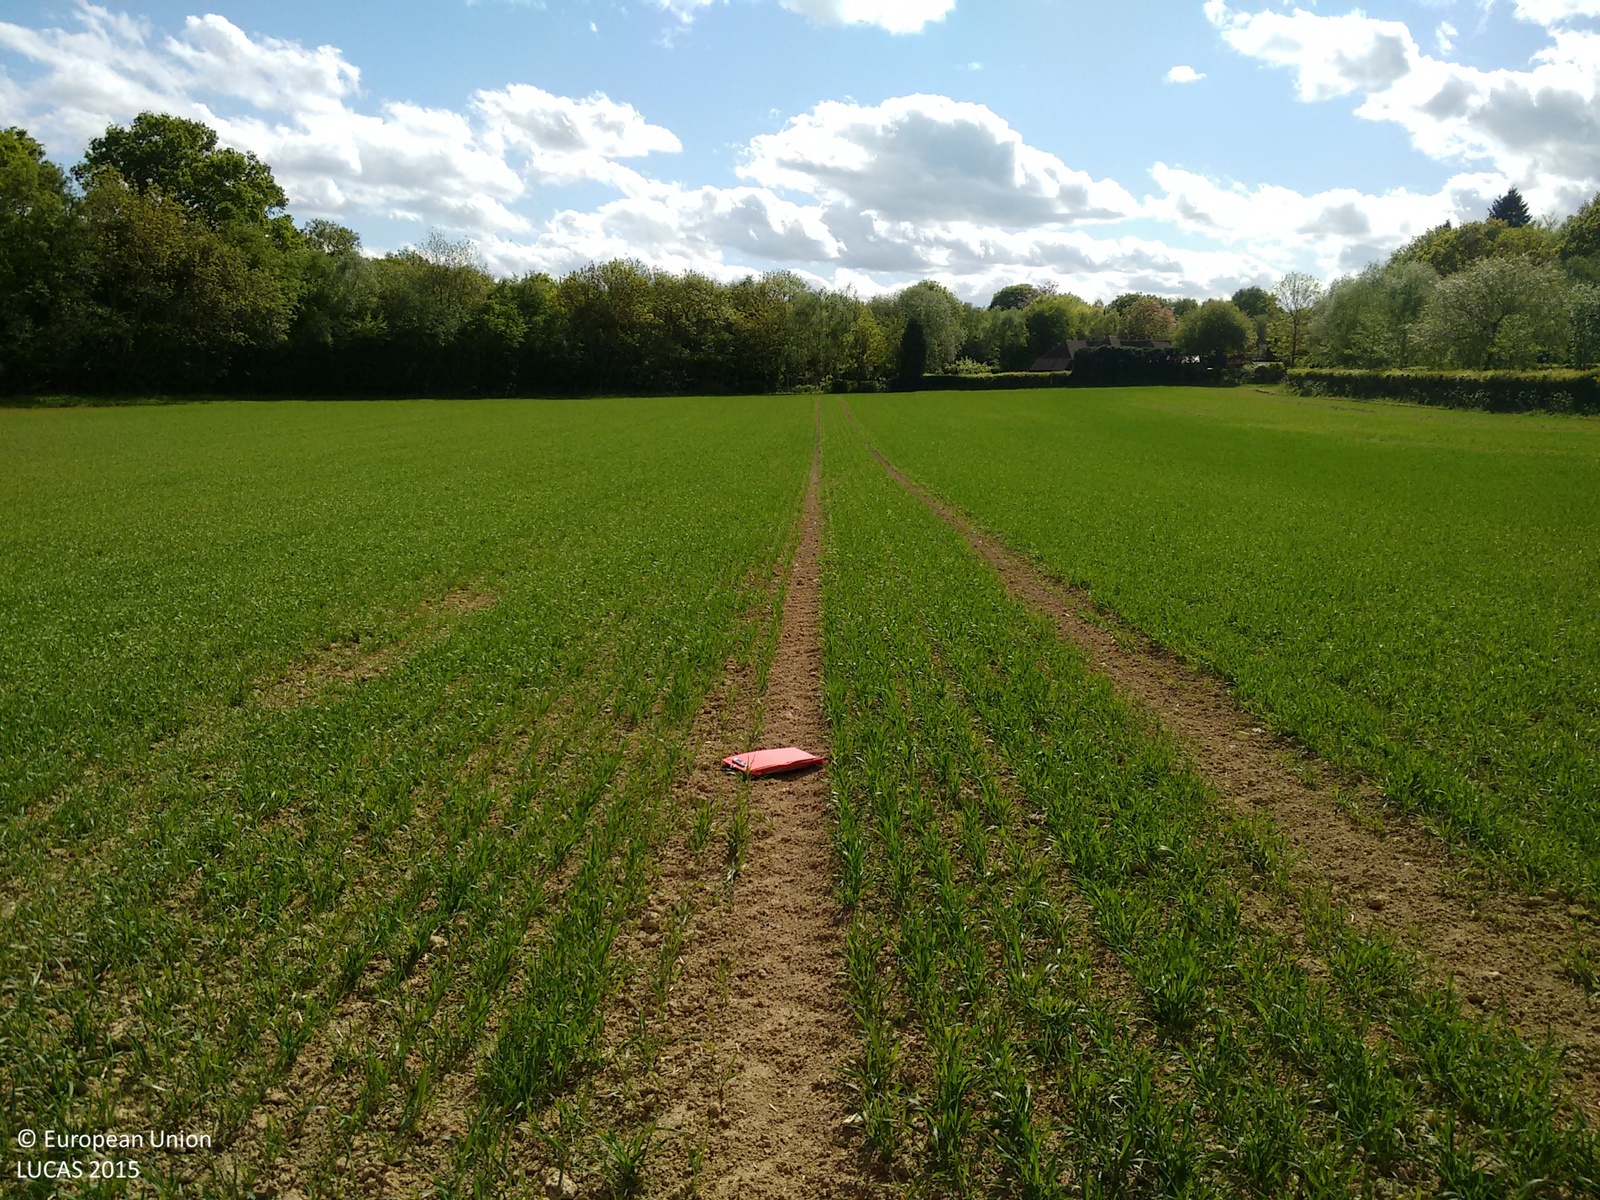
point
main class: Cropland
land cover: Common wheat
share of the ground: 25 - 50 %
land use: Agriculture (excluding fallow land and kitchen gardens)
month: May
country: GB
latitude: 51.2370
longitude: 0.3022
